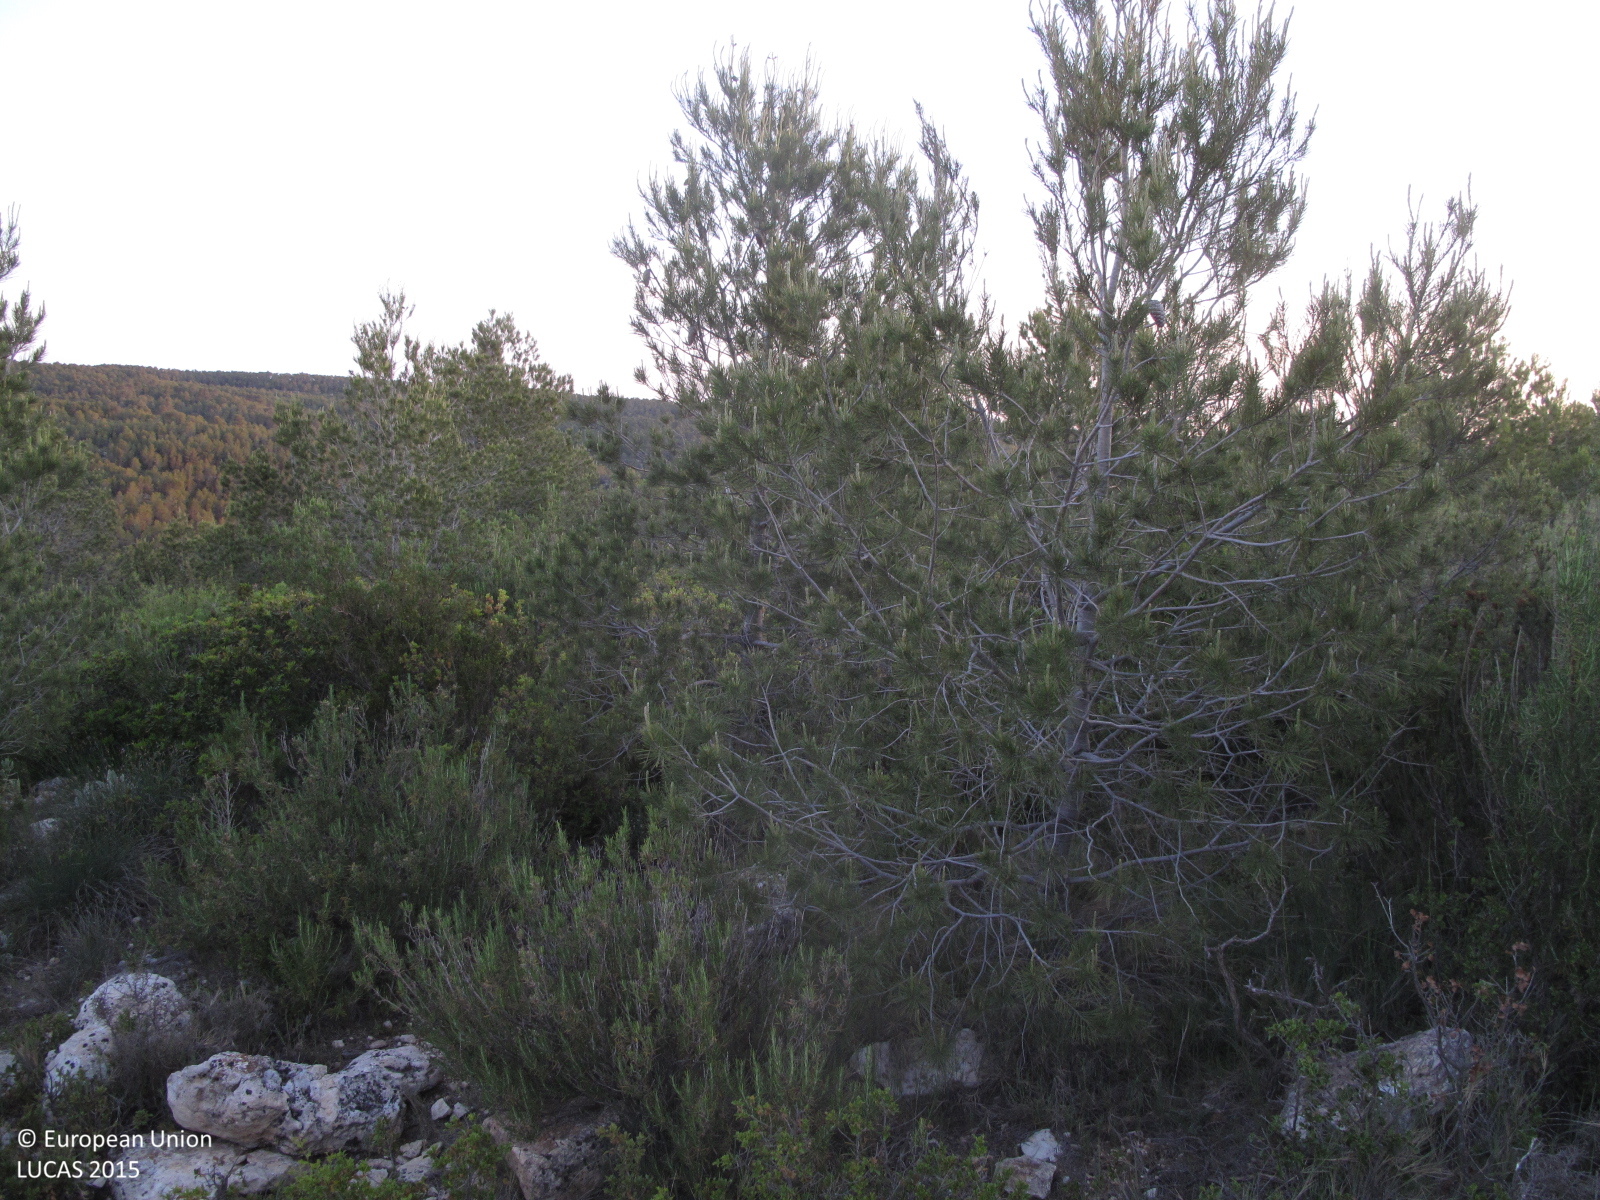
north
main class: Woodland
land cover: Pine dominated coniferous woodland
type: coniferous forest of the mediterranean region
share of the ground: 25 - 50 %
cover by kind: coniferous forest trees 40 %, shrubs 20 %, herbaceous plants 20 %, consolidated bare surface 20 %
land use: Semi-natural and natural areas not in use
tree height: < 5 m
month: May
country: ES
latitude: 39.0491
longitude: -0.7983
